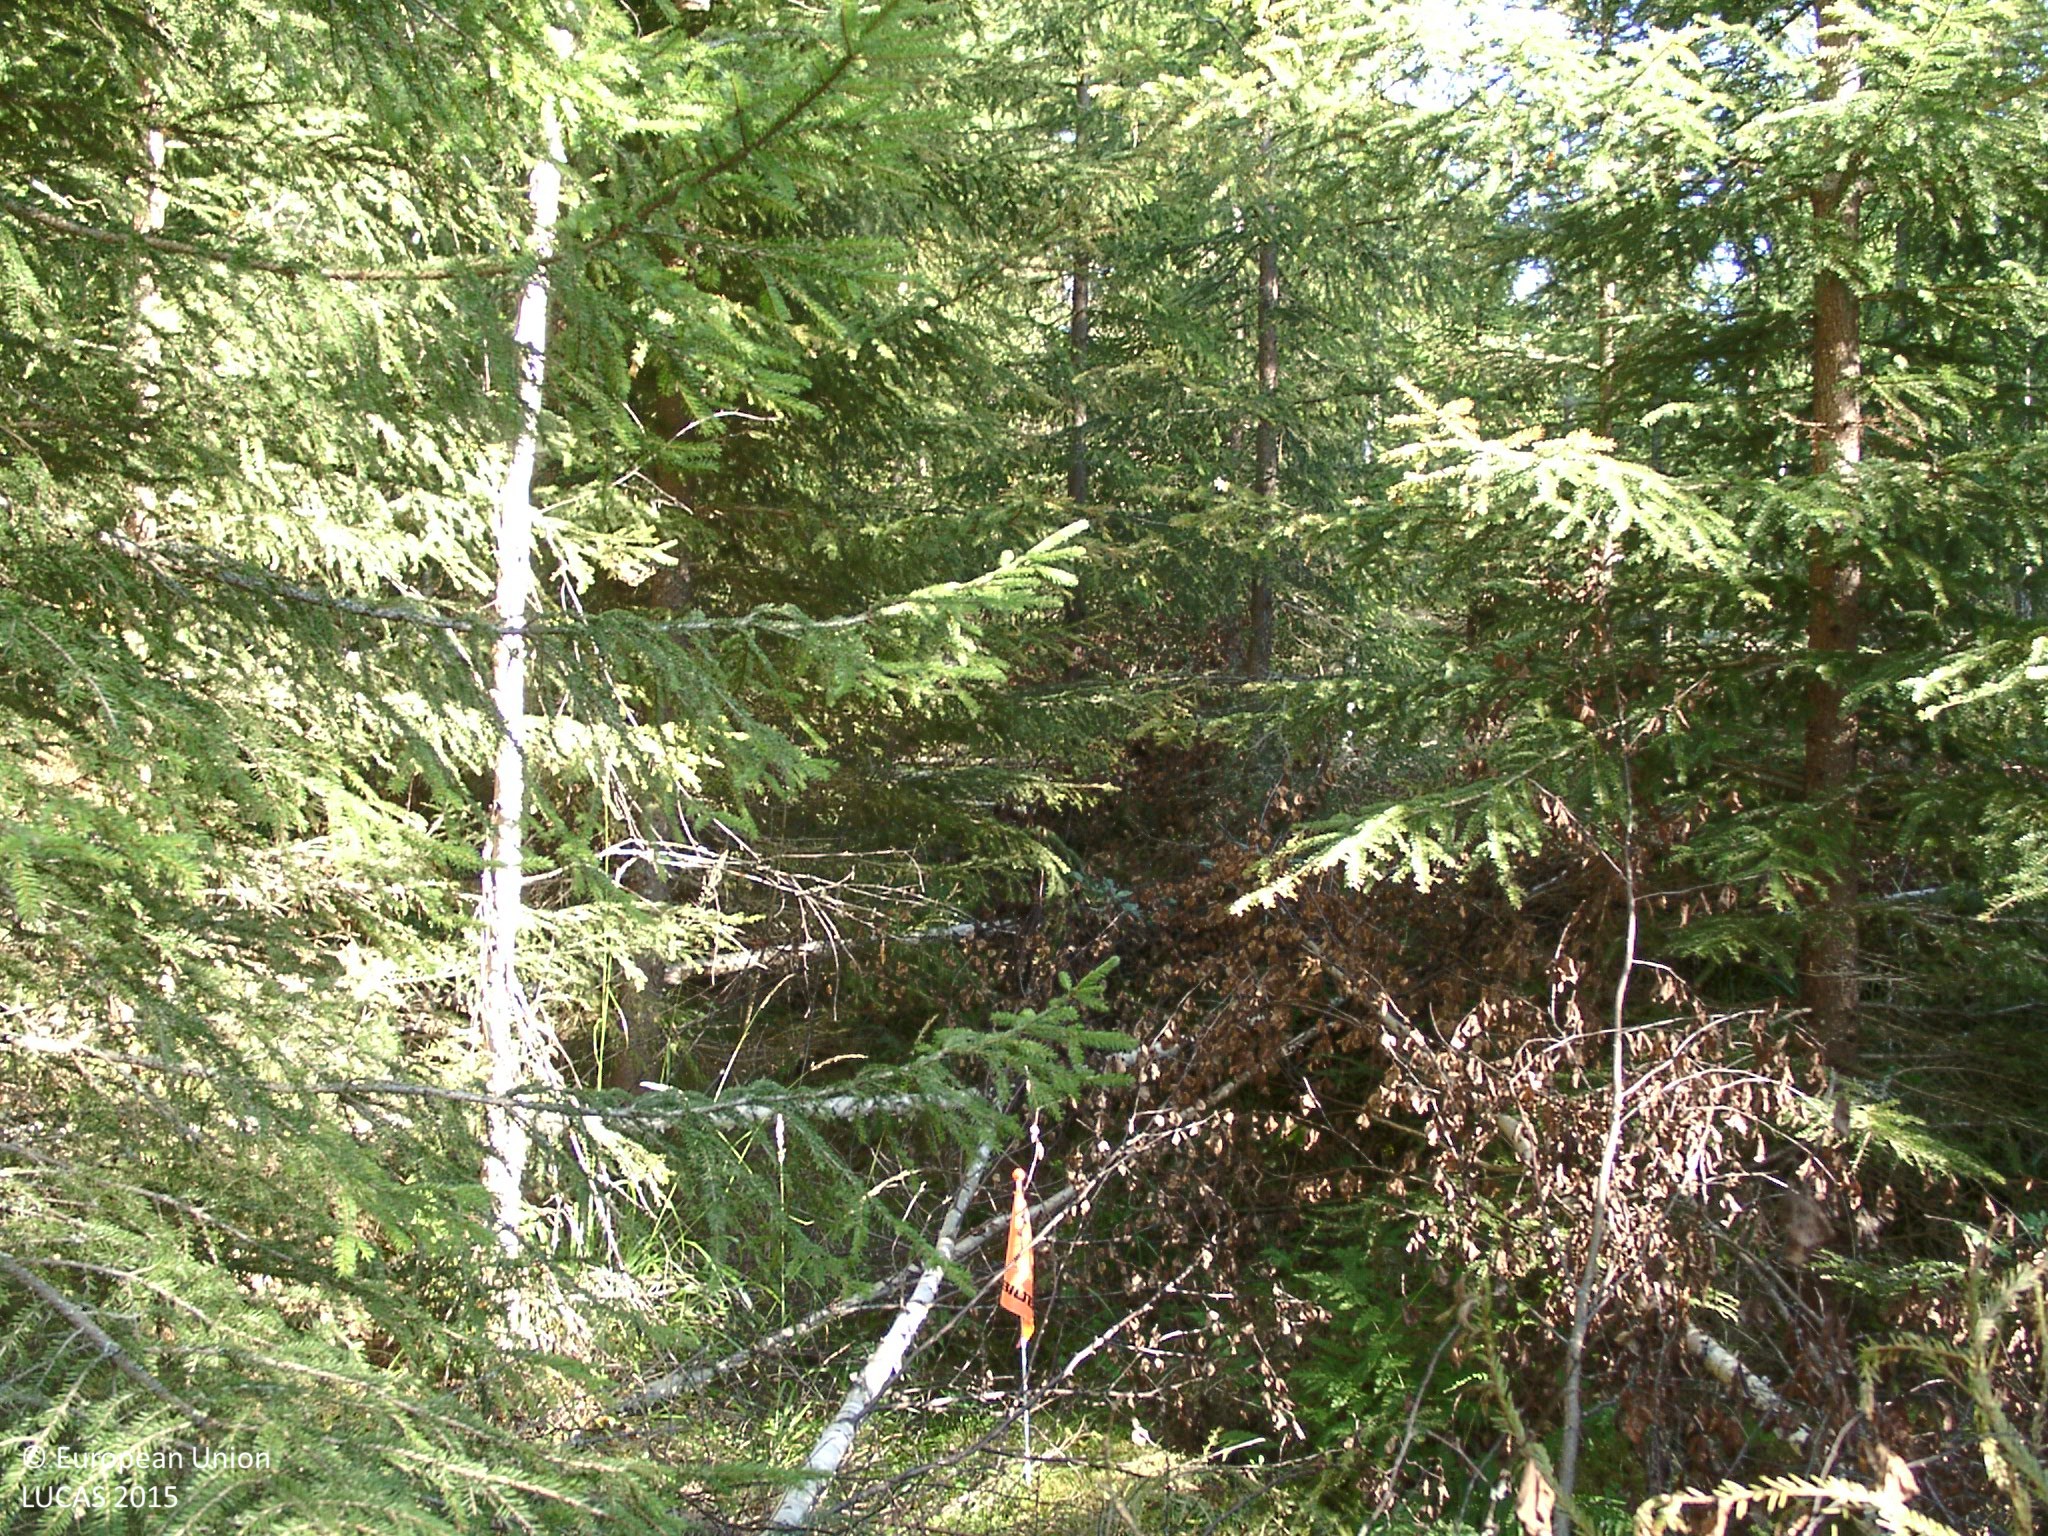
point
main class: Woodland
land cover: Spruce dominated coniferous woodland
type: boreal forest
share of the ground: 50 - 75 %
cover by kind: coniferous forest trees 60 %, broadleaved forest trees 5 %, herbaceous plants 5 %, lichens and mosses 5 %, unconsolidated bare surface 5 %
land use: Forestry
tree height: > 5 m
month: August
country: FI
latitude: 61.6949
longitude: 25.2953
